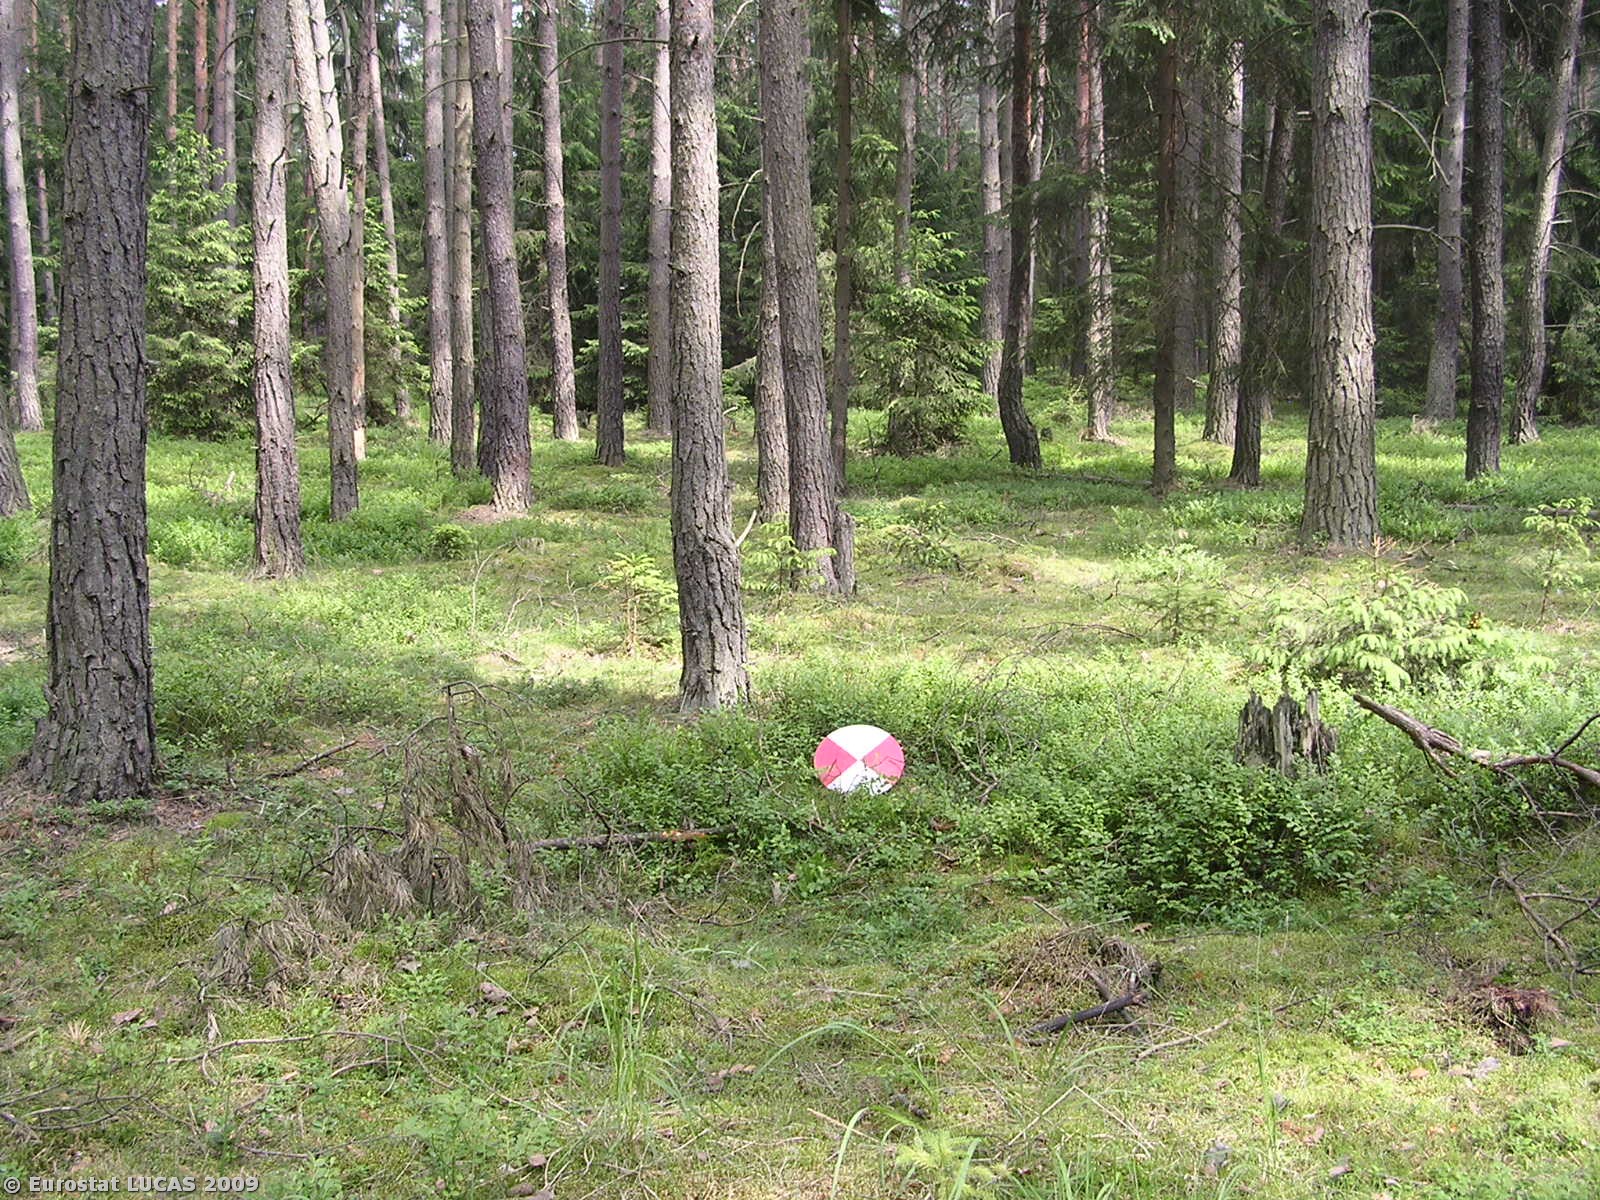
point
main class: Woodland
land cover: Coniferous woodland
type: hemiboreal forest and nemoral coniferous forest and mixed broadleaved-coniferous forest
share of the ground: > 75 %
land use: Forestry
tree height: > 5 m
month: June
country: CZ
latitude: 50.5903
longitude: 14.7343
